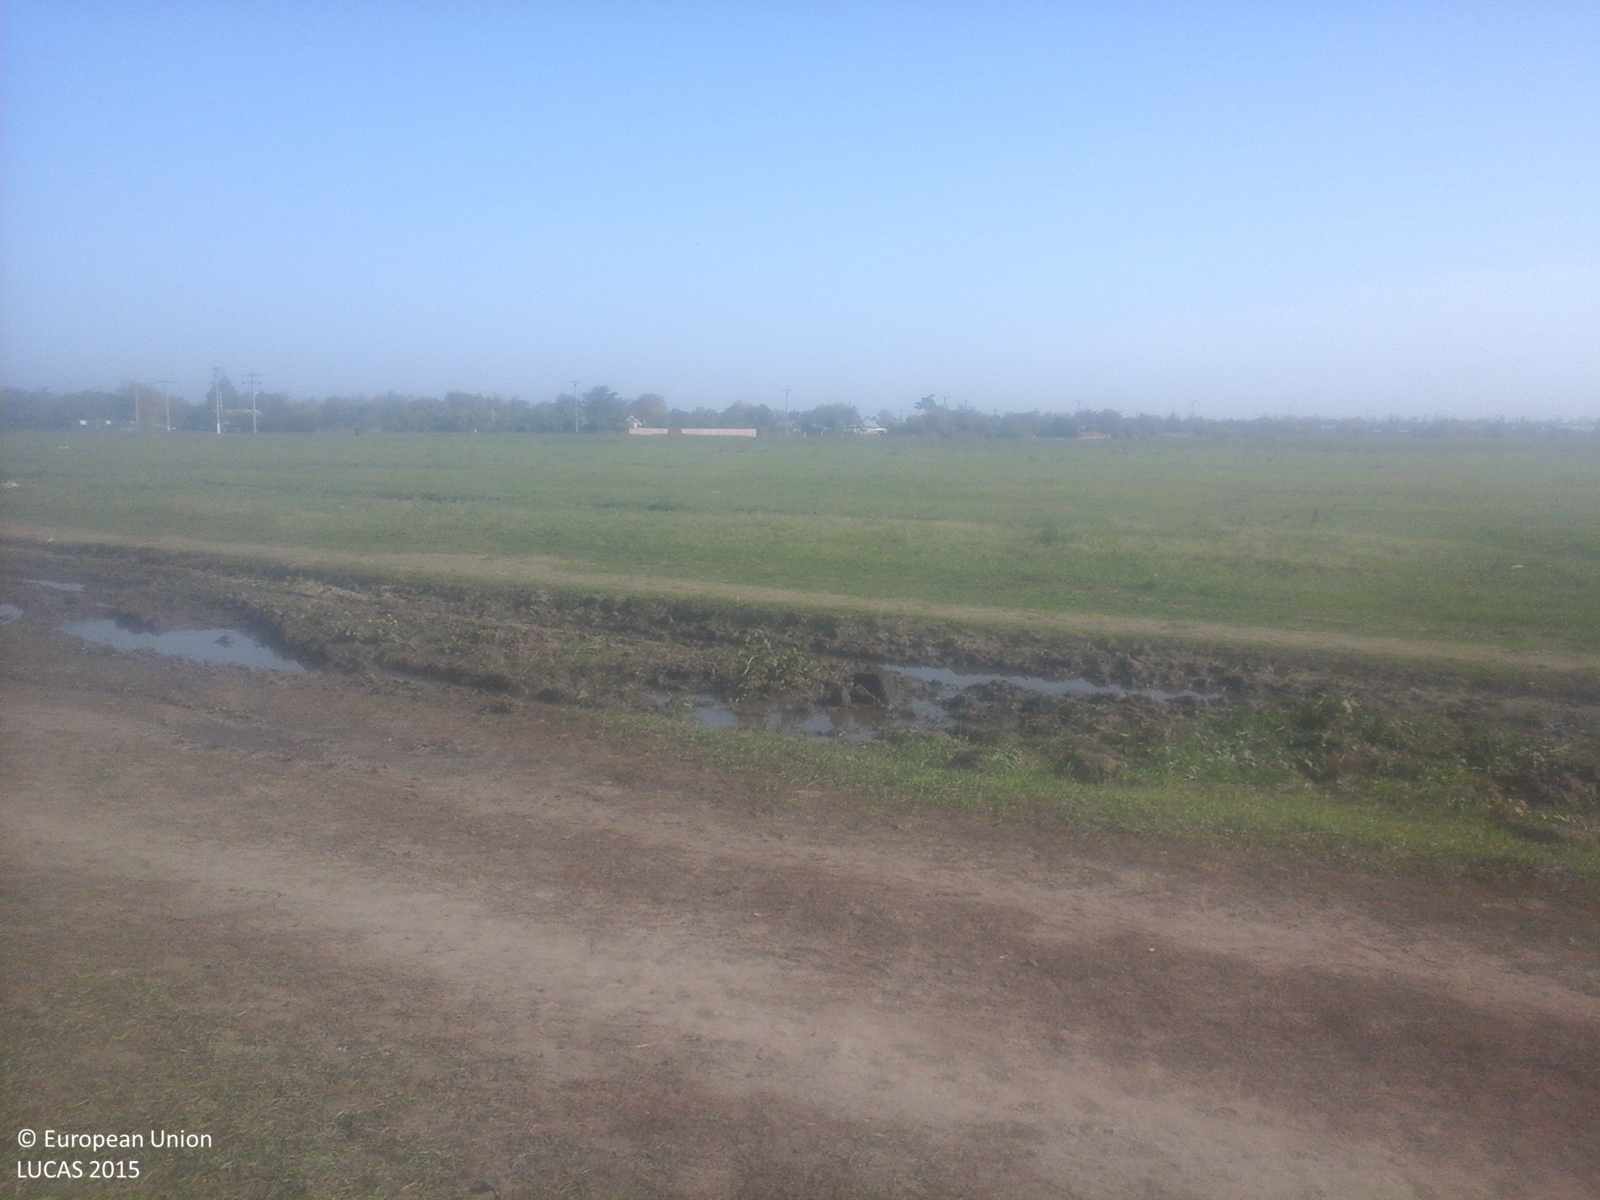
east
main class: Grassland
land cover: Grassland without tree/shrub cover
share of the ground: > 75 %
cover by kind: herbaceous plants 100 %
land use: Agriculture (excluding fallow land and kitchen gardens)
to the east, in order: Grassland without tree/shrub cover; Tracks; Grass margins; Tracks; Grass margins; Ditches and canals; Grassland without tree/shrub cover
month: October
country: RO
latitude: 45.3592
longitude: 27.0277
